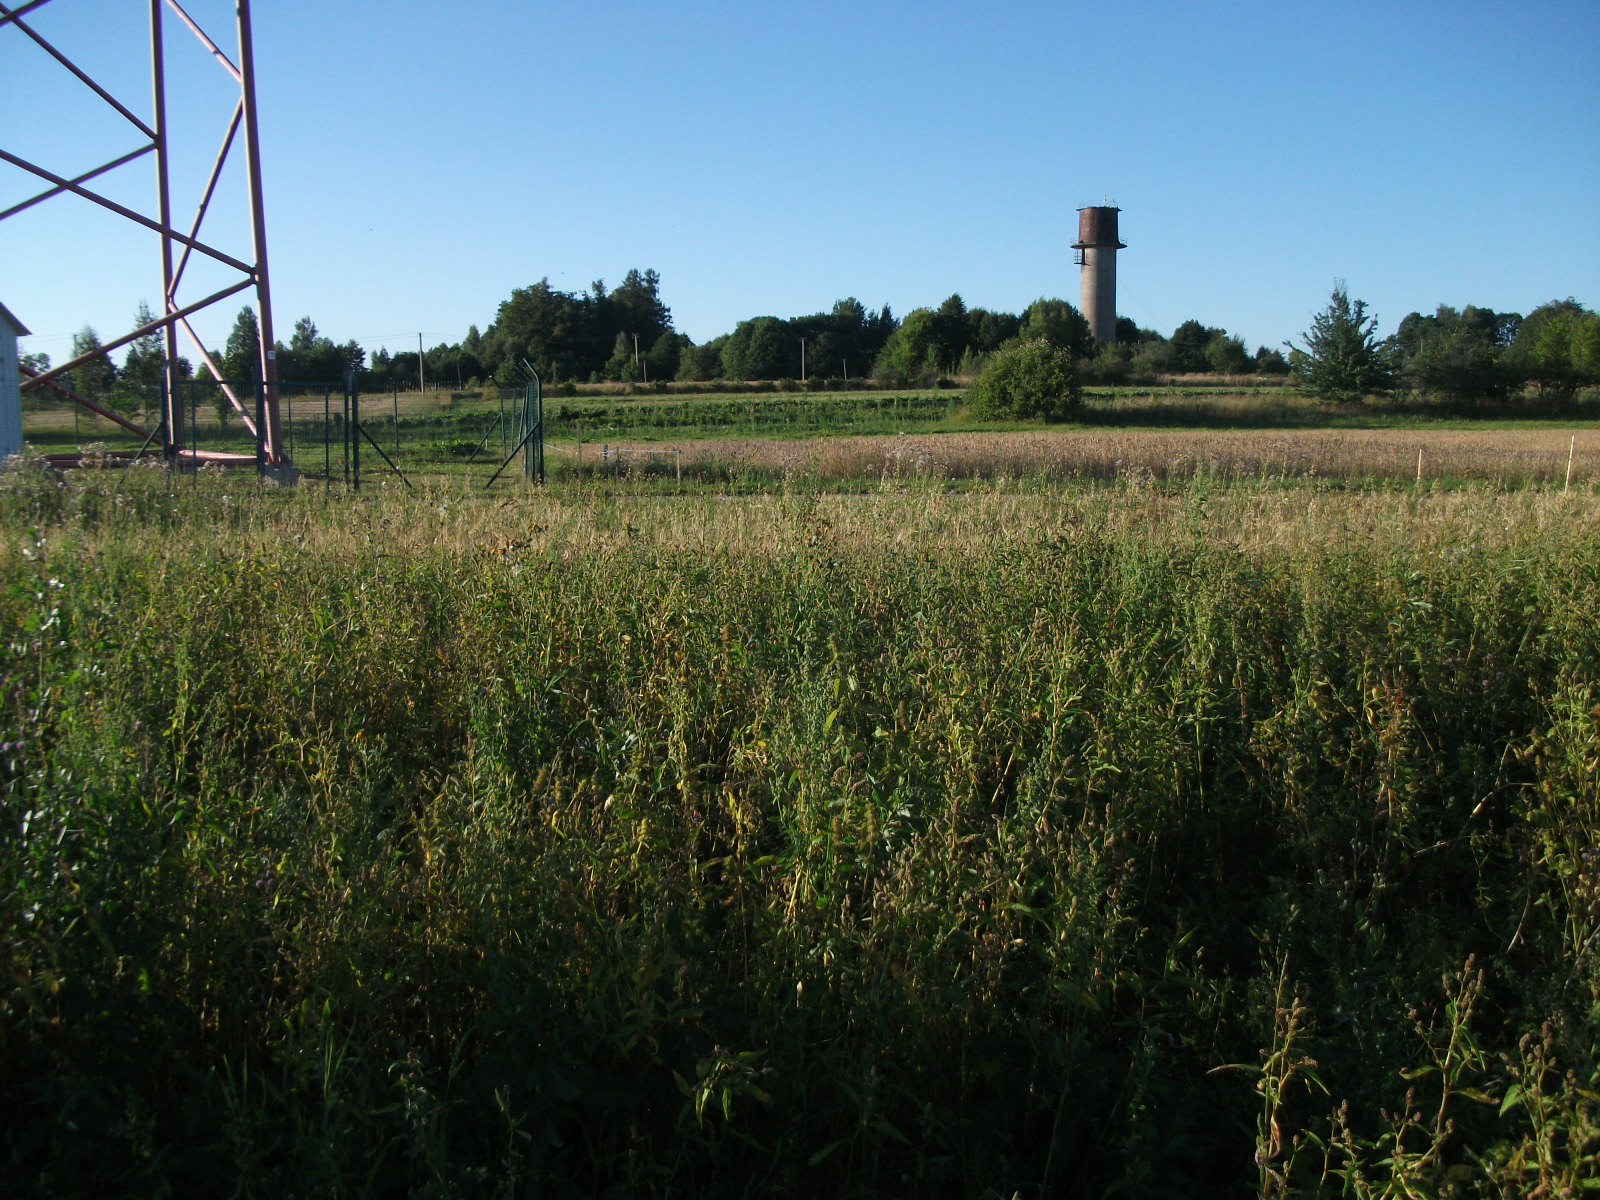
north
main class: Cropland
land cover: Potatoes
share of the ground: > 75 %
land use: Kitchen garden
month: August
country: LV
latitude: 56.5396
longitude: 26.3905
